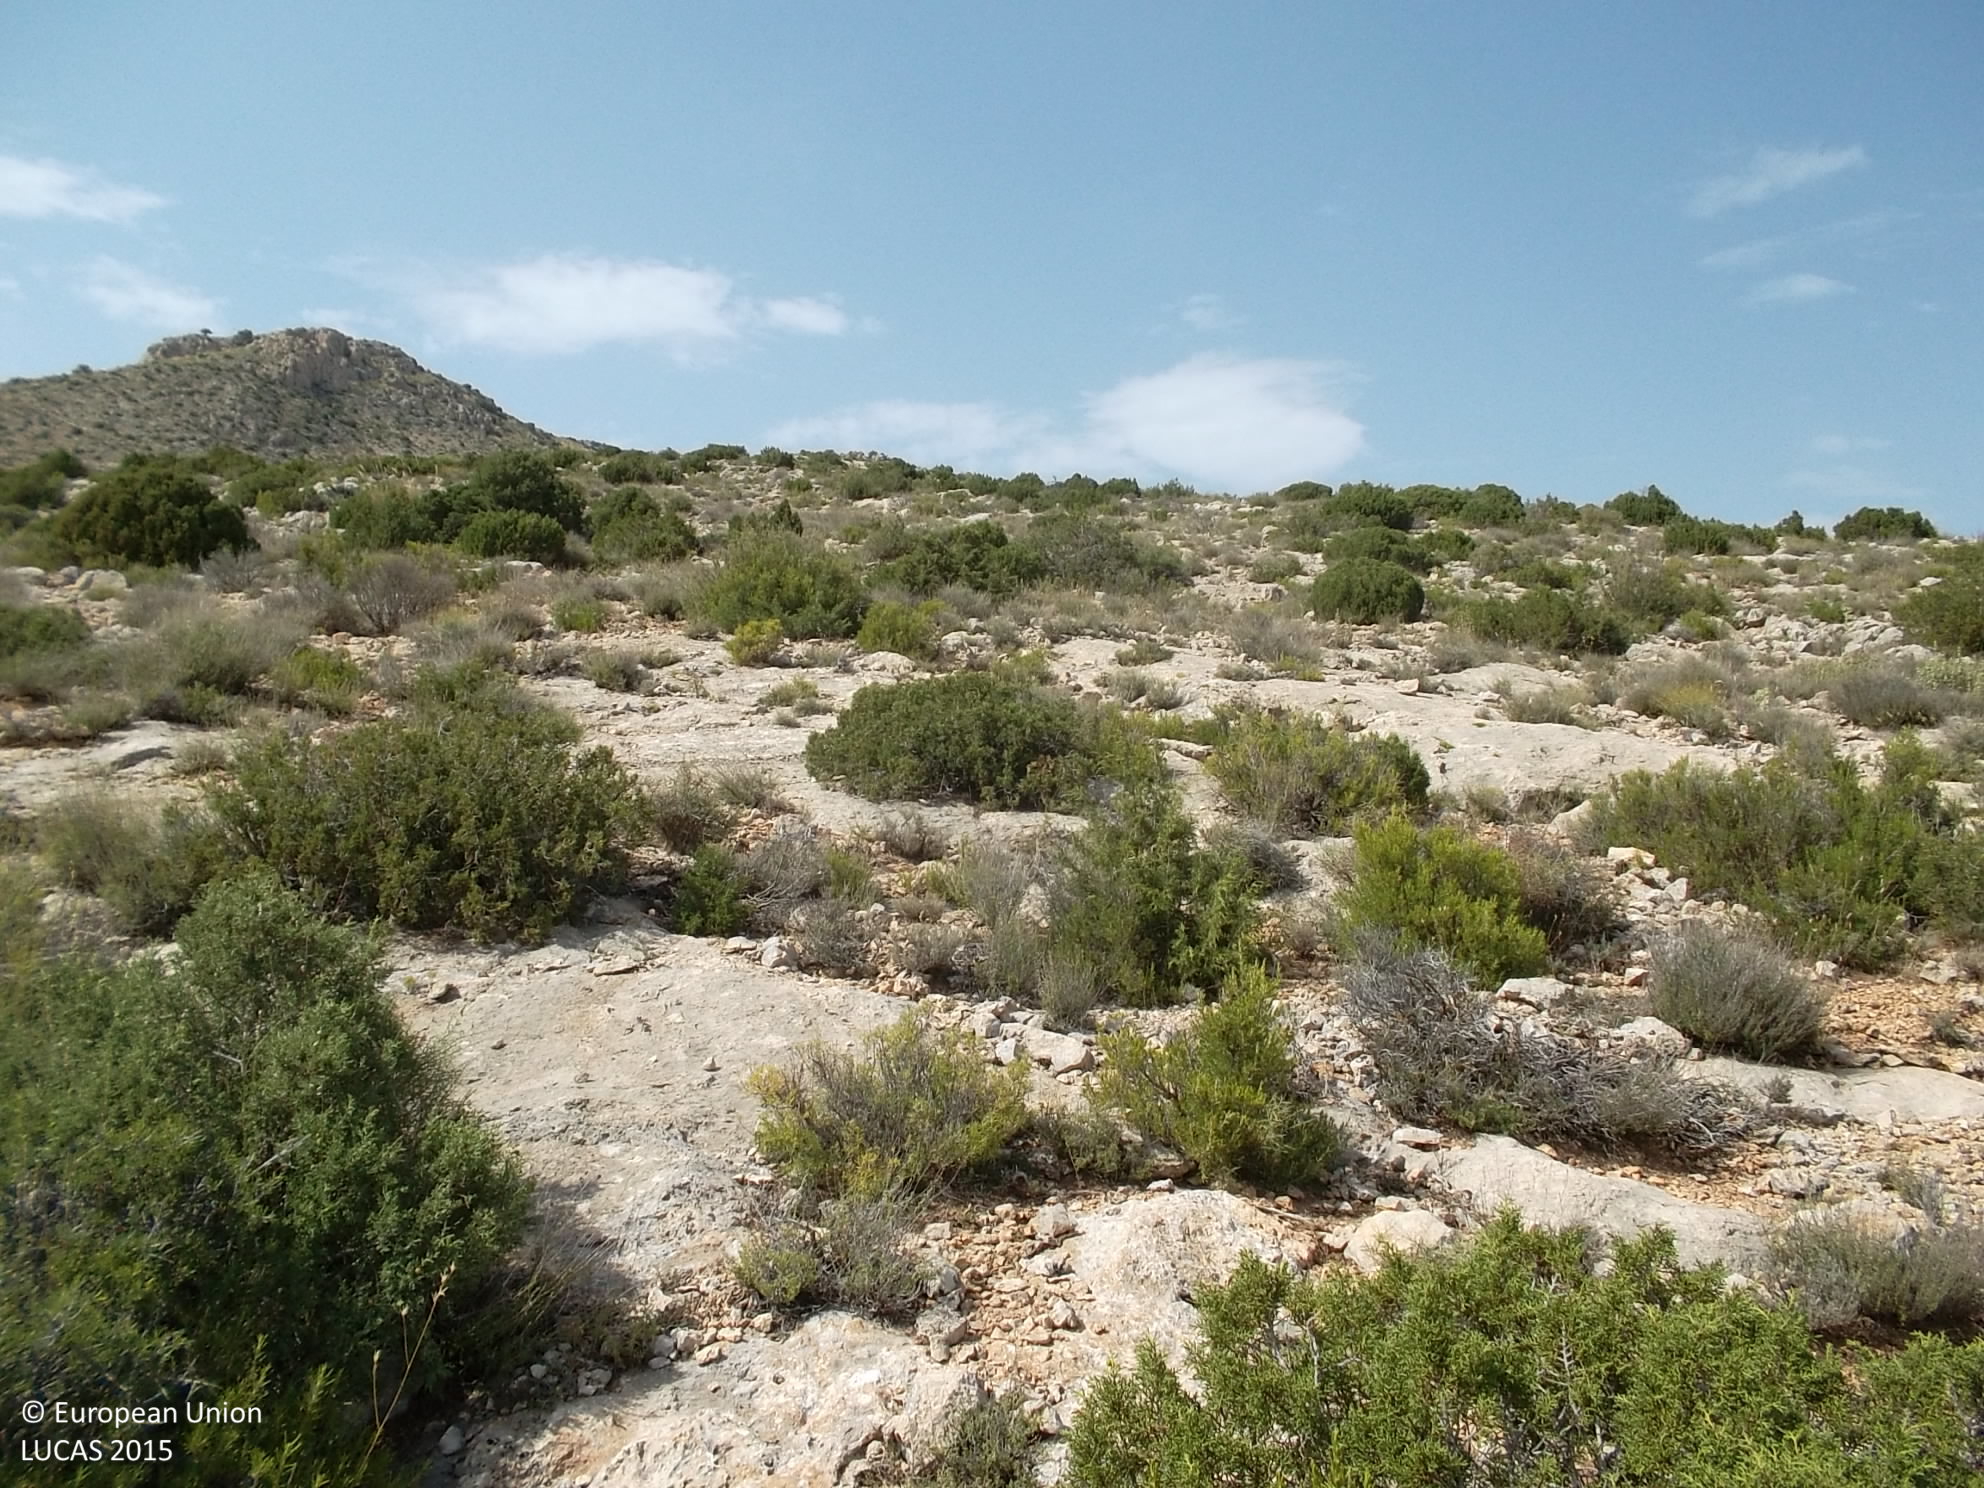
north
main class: Shrubland
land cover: Shrubland without tree cover
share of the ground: 50 - 75 %
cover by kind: shrubs 50 %, consolidated bare surface 30 %, herbaceous plants 20 %
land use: Semi-natural and natural areas not in use
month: July
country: ES
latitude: 37.9188
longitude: -2.4239
